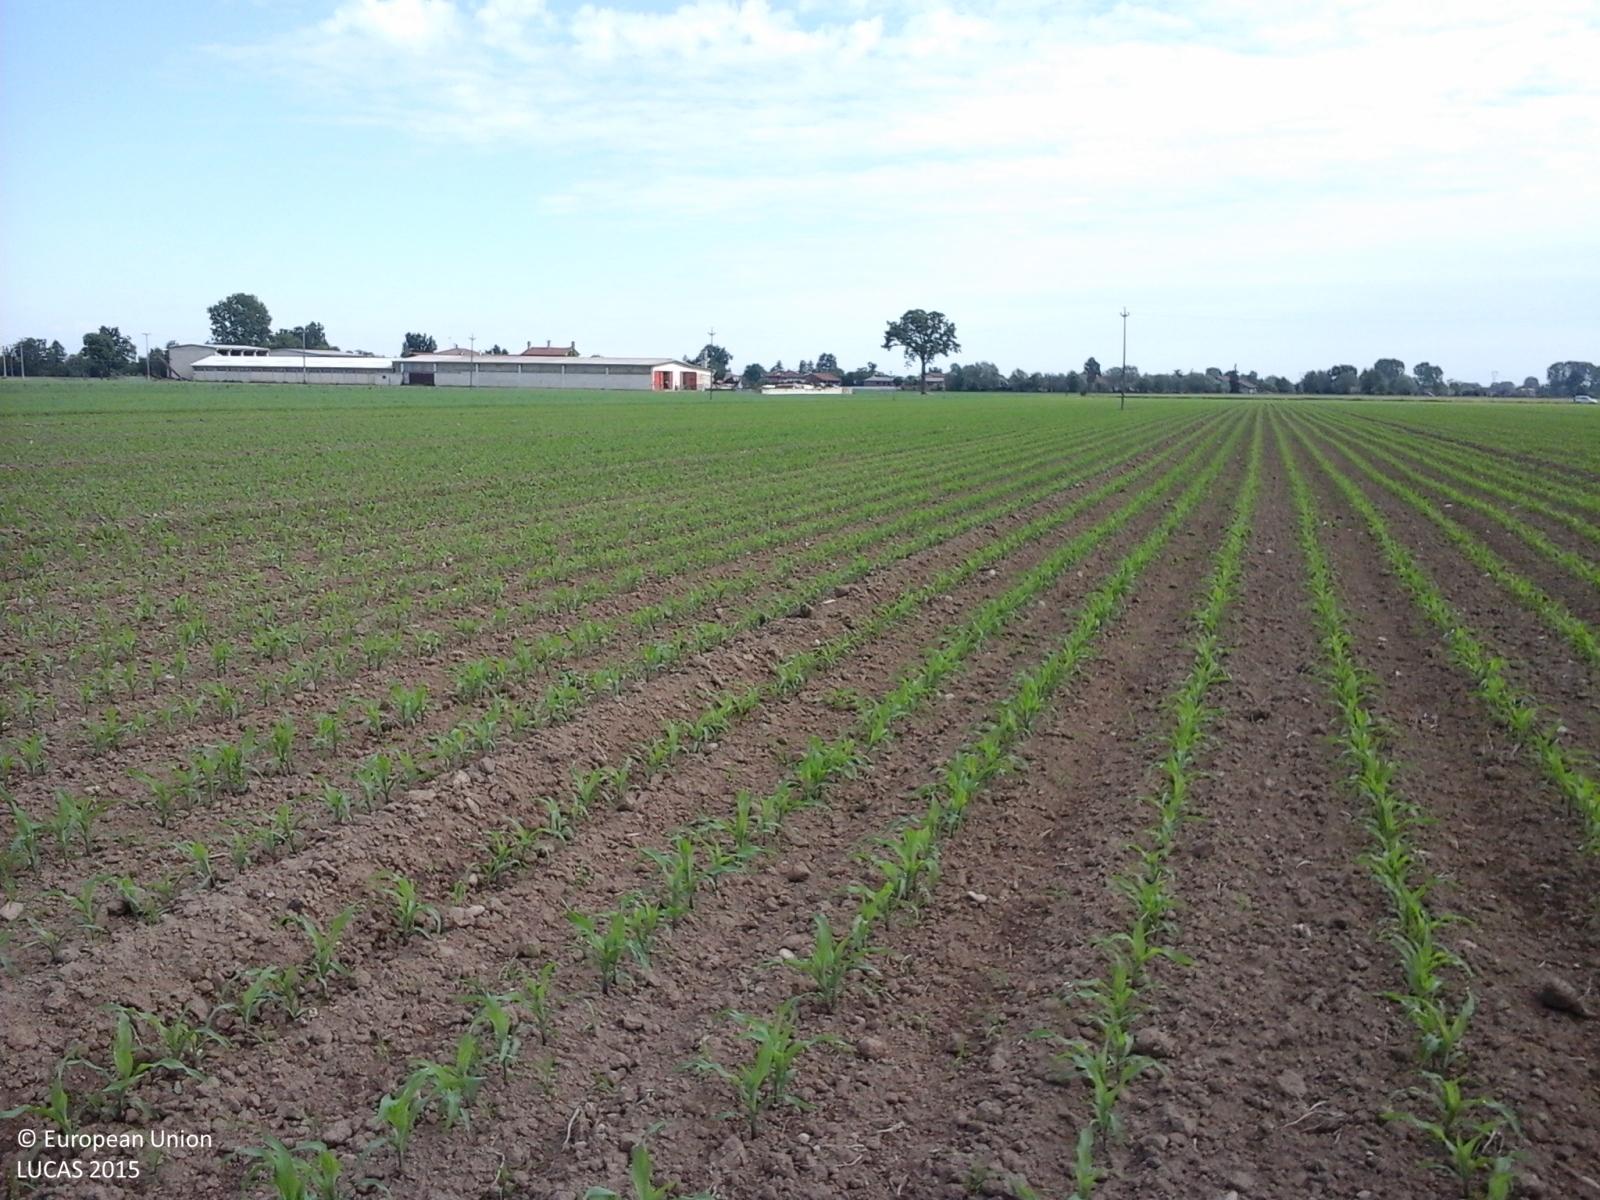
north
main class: Cropland
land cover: Maize
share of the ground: 10 - 25 %
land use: Agriculture (excluding fallow land and kitchen gardens)
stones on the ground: 10 - 25 %
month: May
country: IT
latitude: 44.4706
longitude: 7.7545
